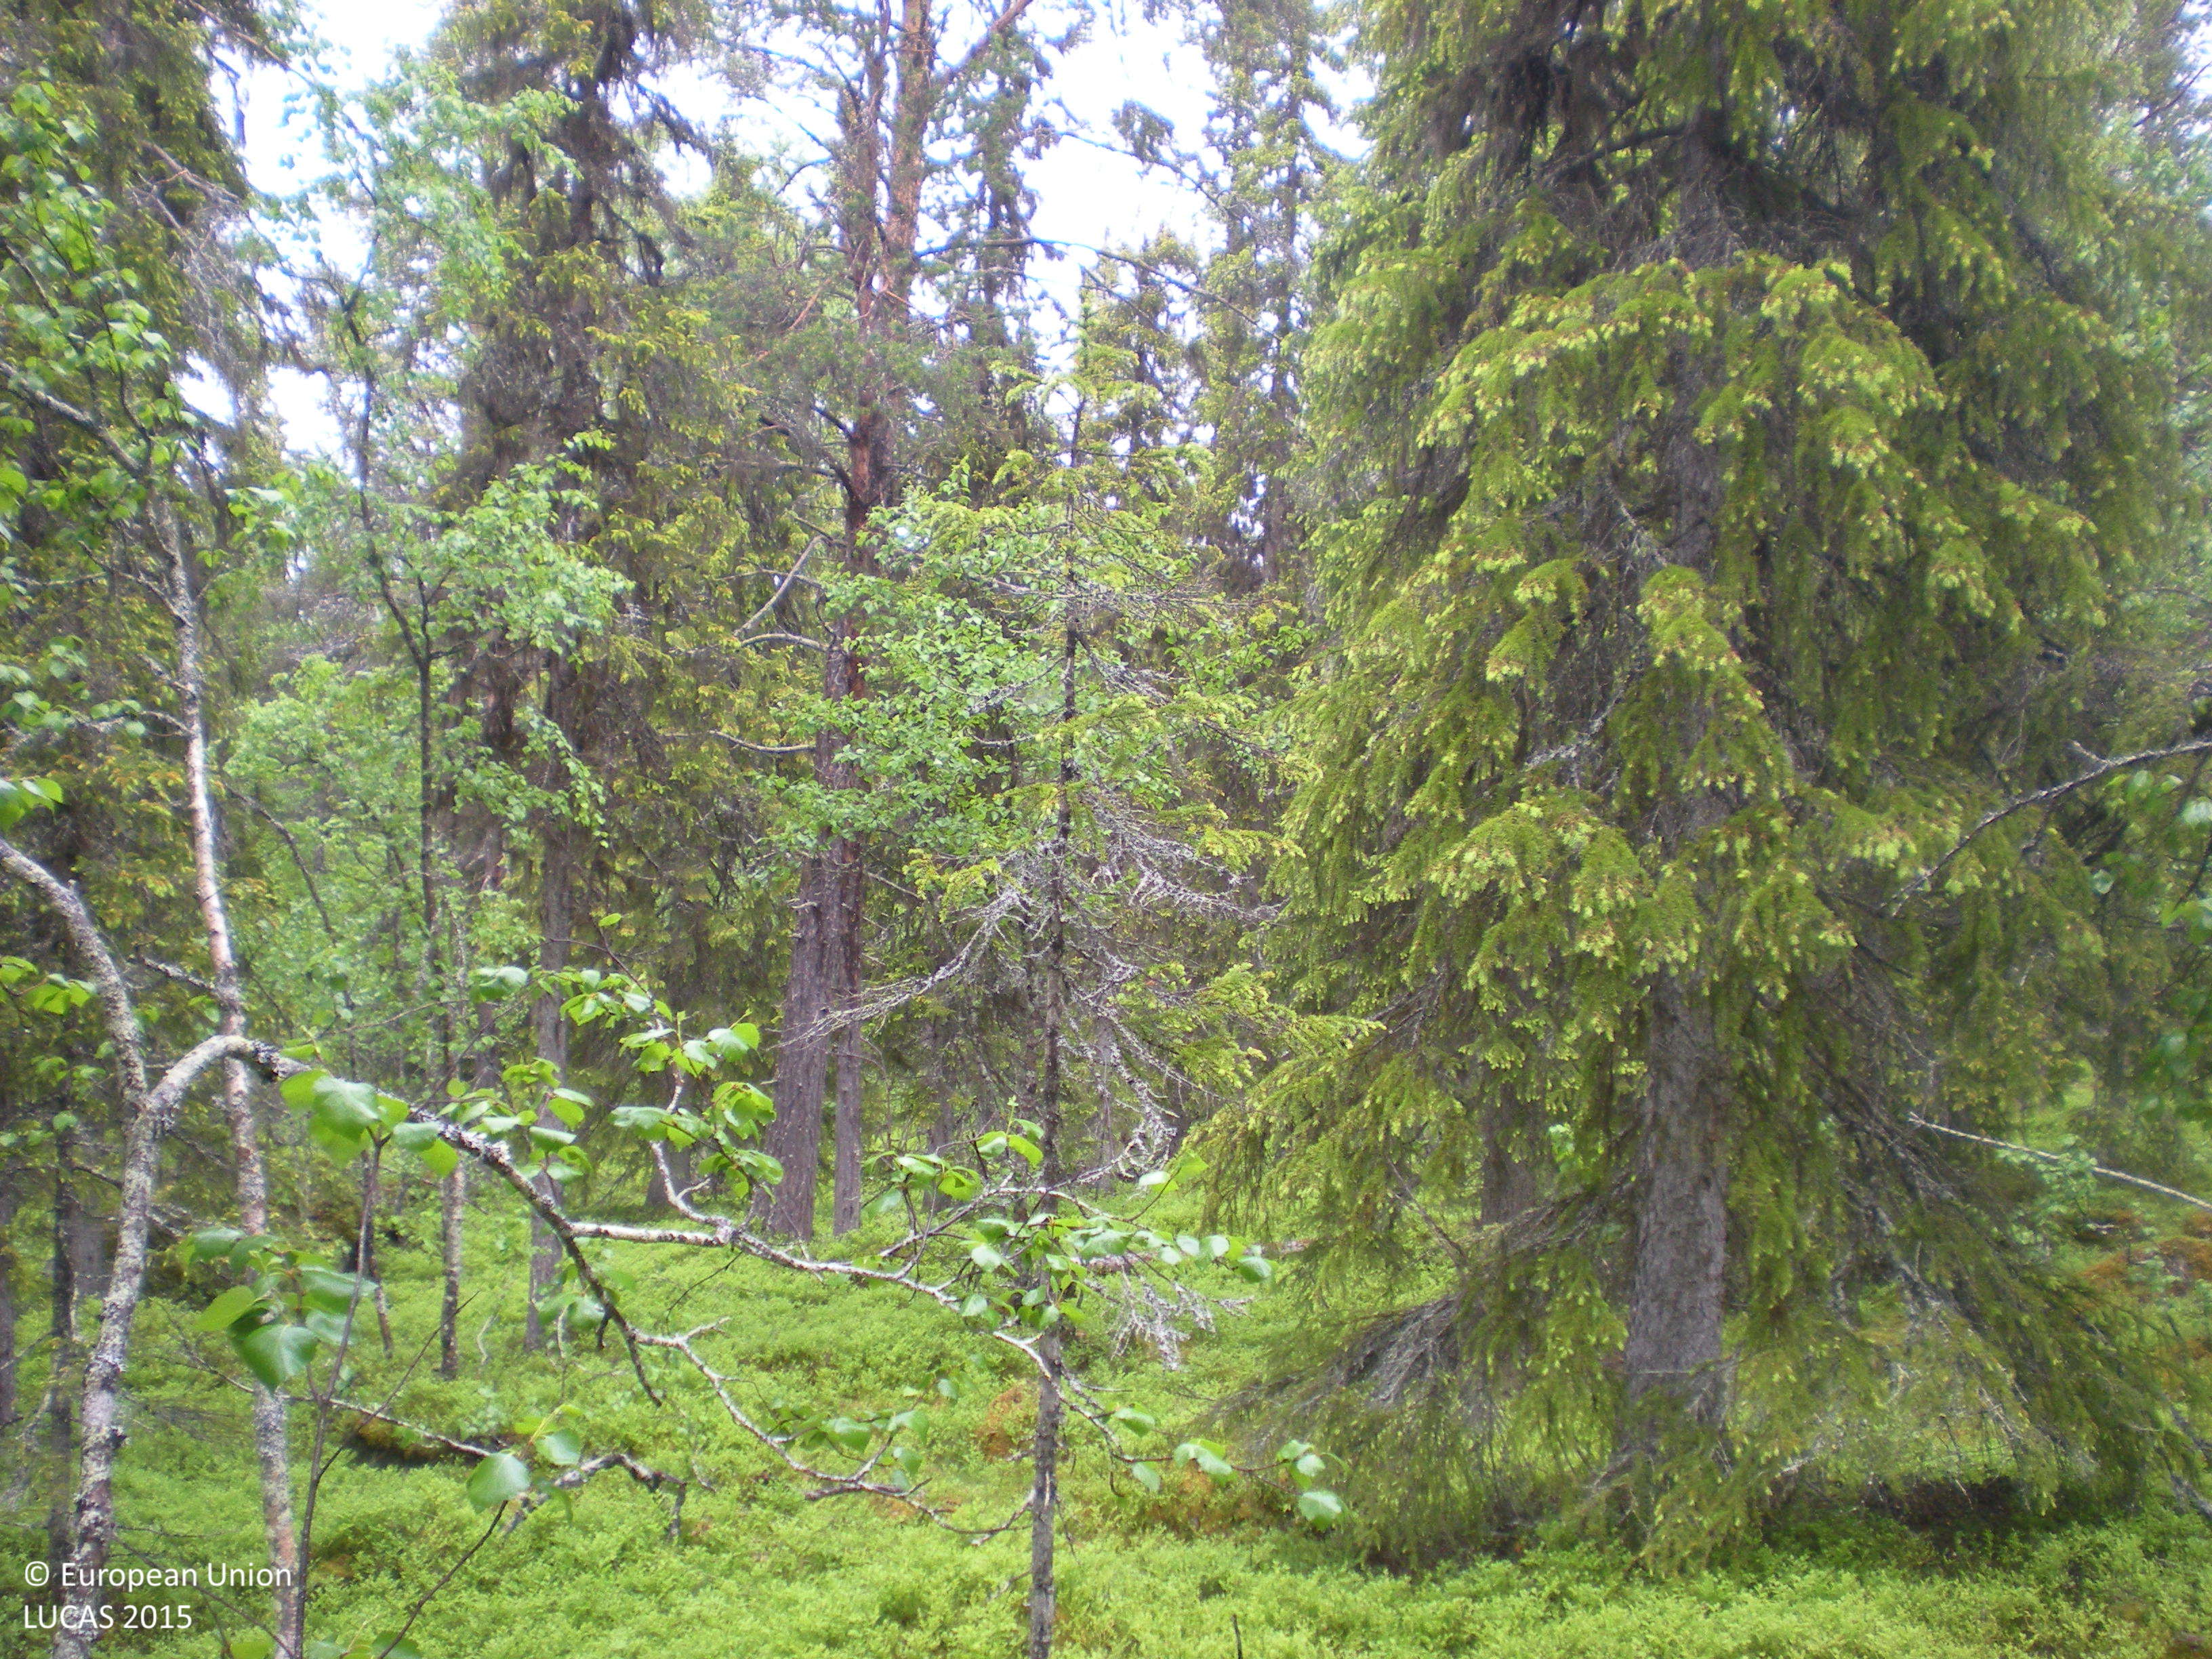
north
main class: Woodland
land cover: Other mixed woodland
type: boreal forest
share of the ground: 50 - 75 %
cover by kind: coniferous forest trees 55 %, broadleaved forest trees 20 %, shrubs 15 %, herbaceous plants 5 %, lichens and mosses 5 %
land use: Forestry
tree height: > 5 m
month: July
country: SE
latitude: 66.0600
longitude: 17.3983
